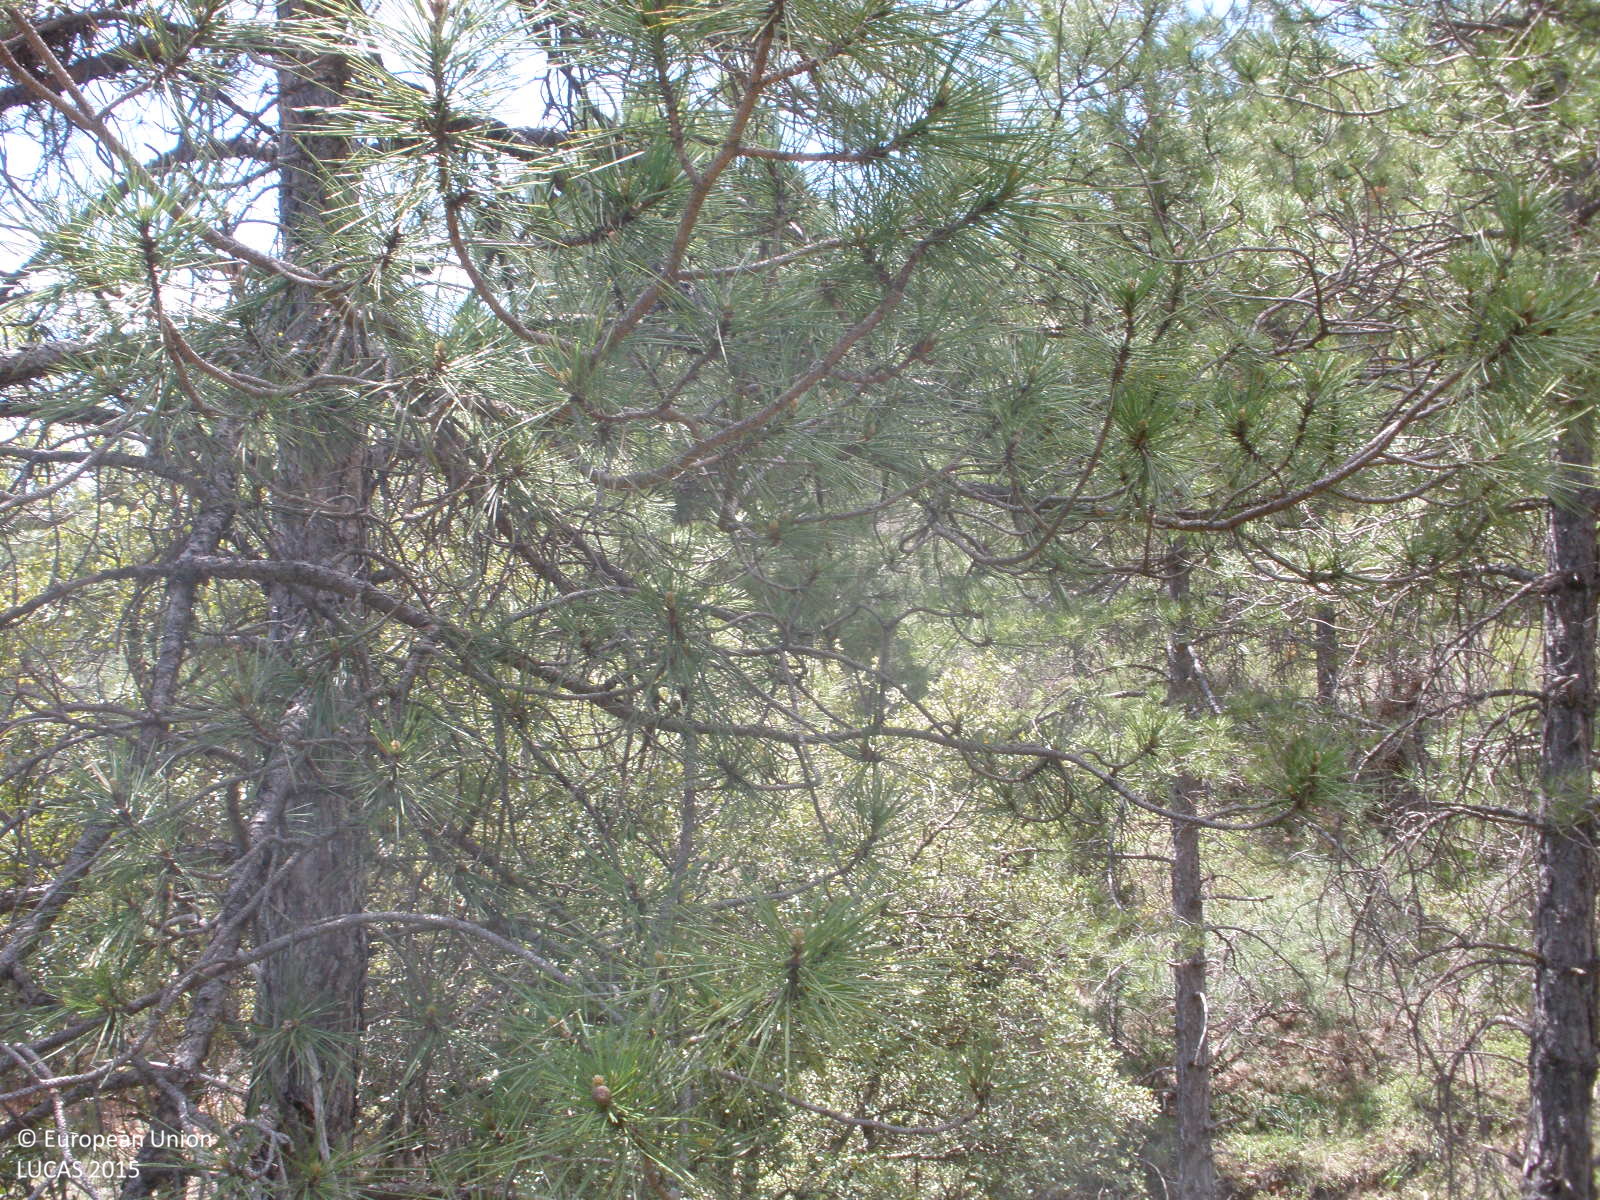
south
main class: Woodland
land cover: Pine dominated coniferous woodland
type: coniferous forest of the mediterranean region
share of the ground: 25 - 50 %
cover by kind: shrubs 60 %, coniferous forest trees 30 %, consolidated bare surface 10 %
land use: Semi-natural and natural areas not in use
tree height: > 5 m
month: May
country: ES
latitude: 40.9134
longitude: -0.9264
